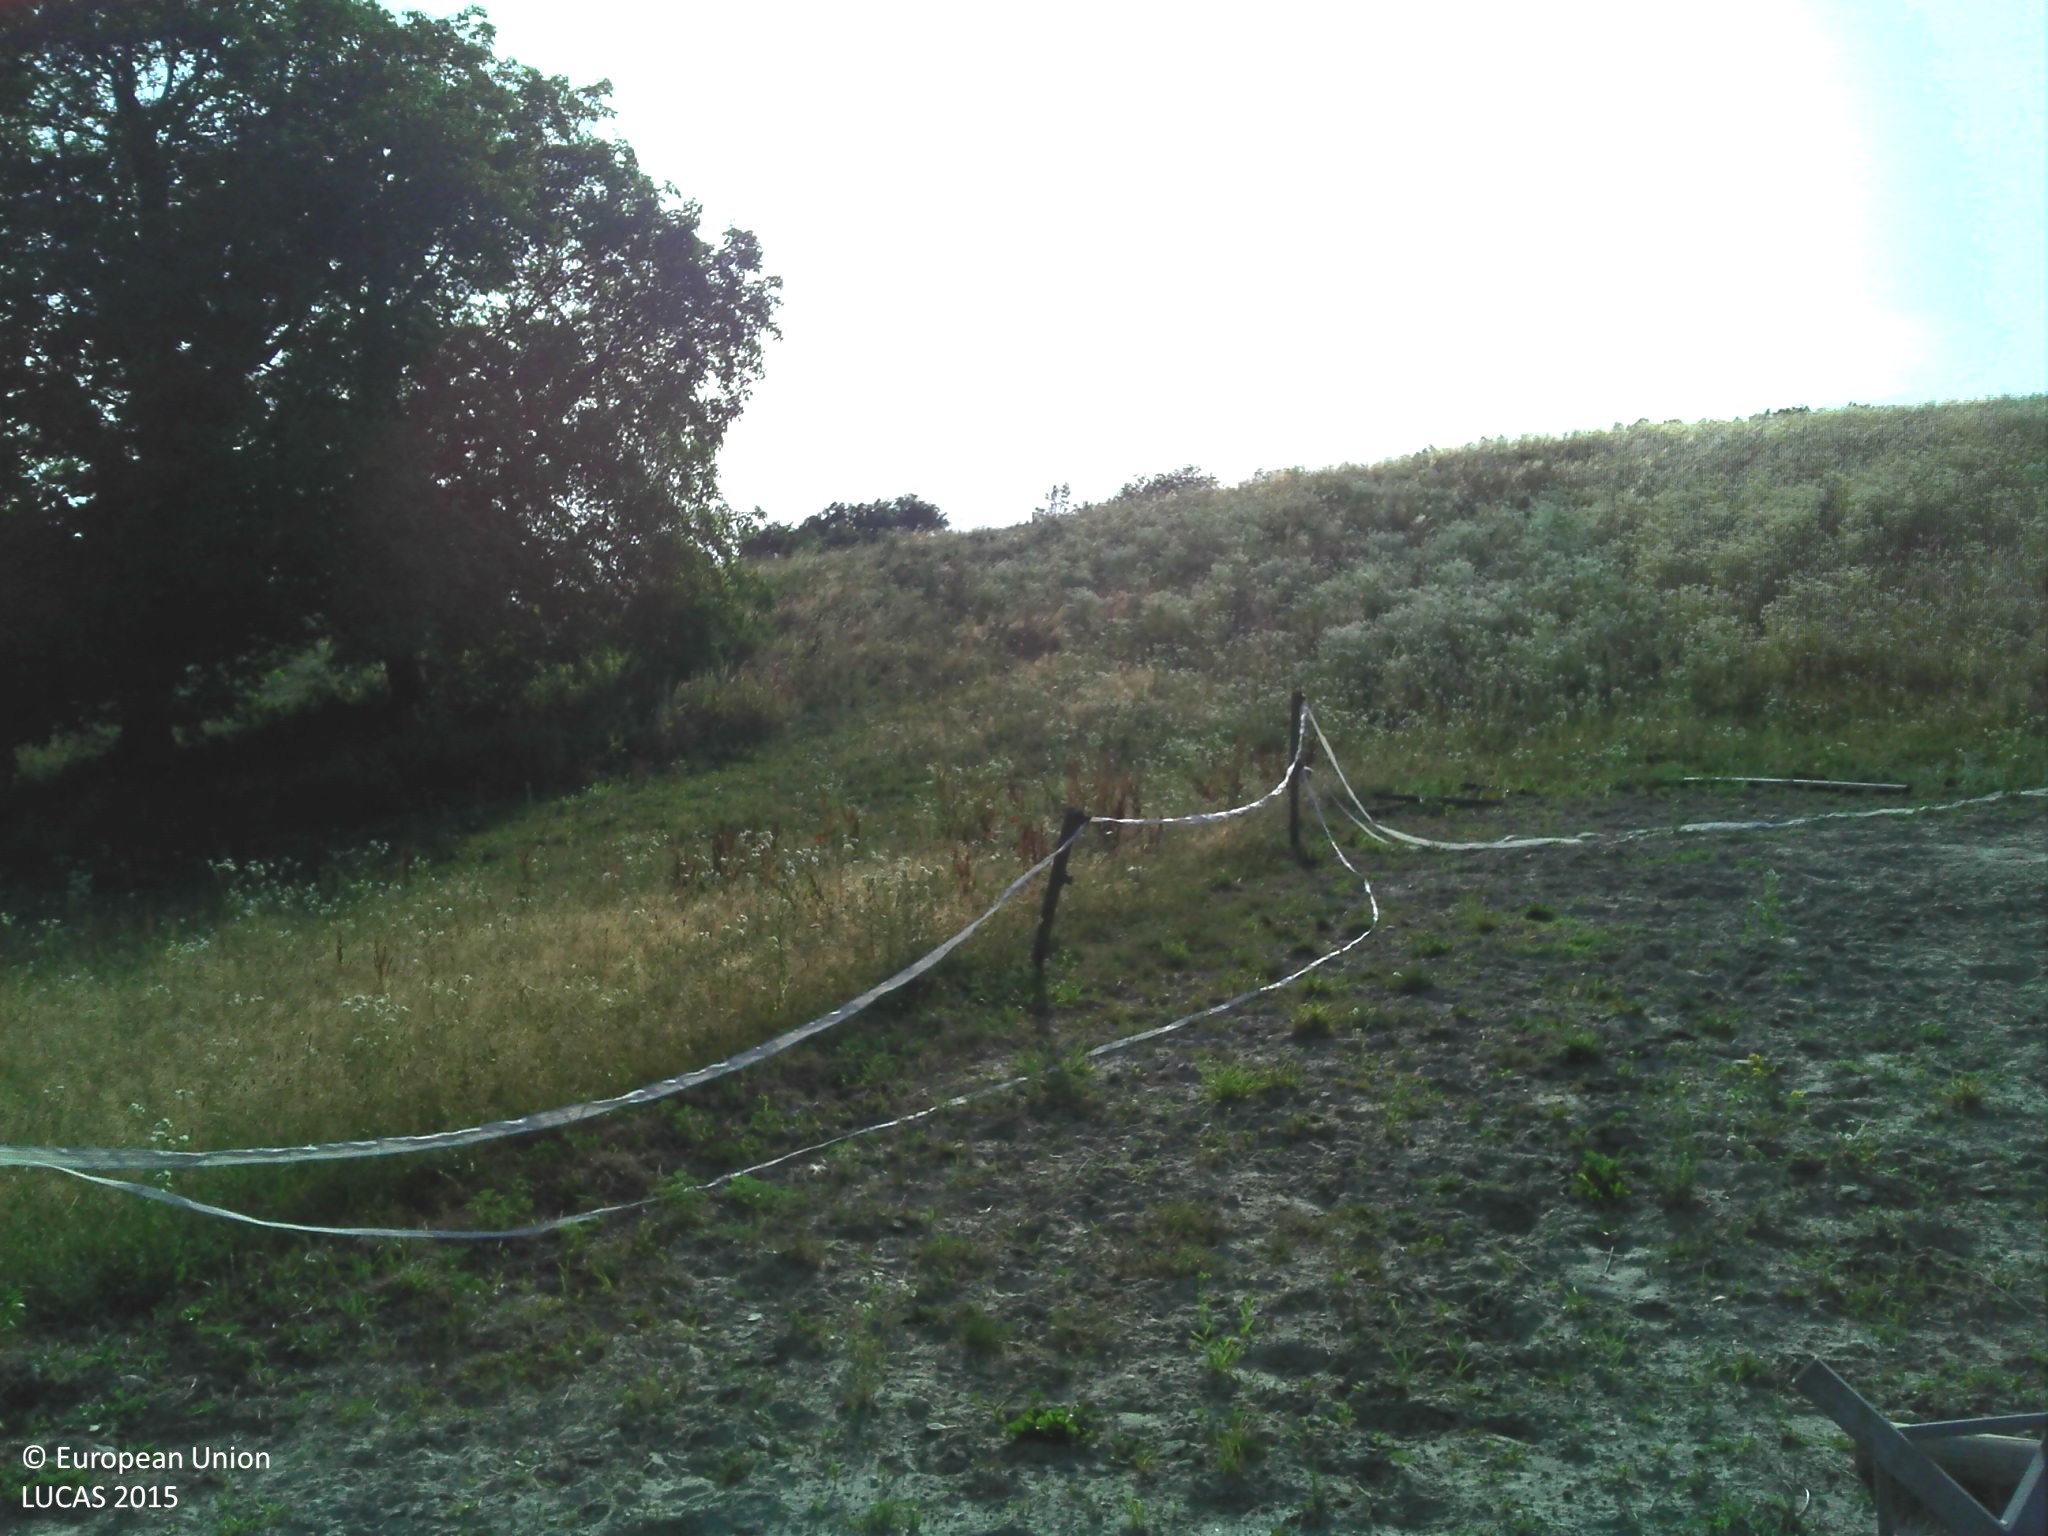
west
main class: Grassland
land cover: Grassland without tree/shrub cover
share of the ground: > 75 %
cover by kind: unconsolidated bare surface 85 %, herbaceous plants 15 %
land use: Agriculture (excluding fallow land and kitchen gardens)
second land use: Sport
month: July
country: FR
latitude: 45.5577
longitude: 5.2003
